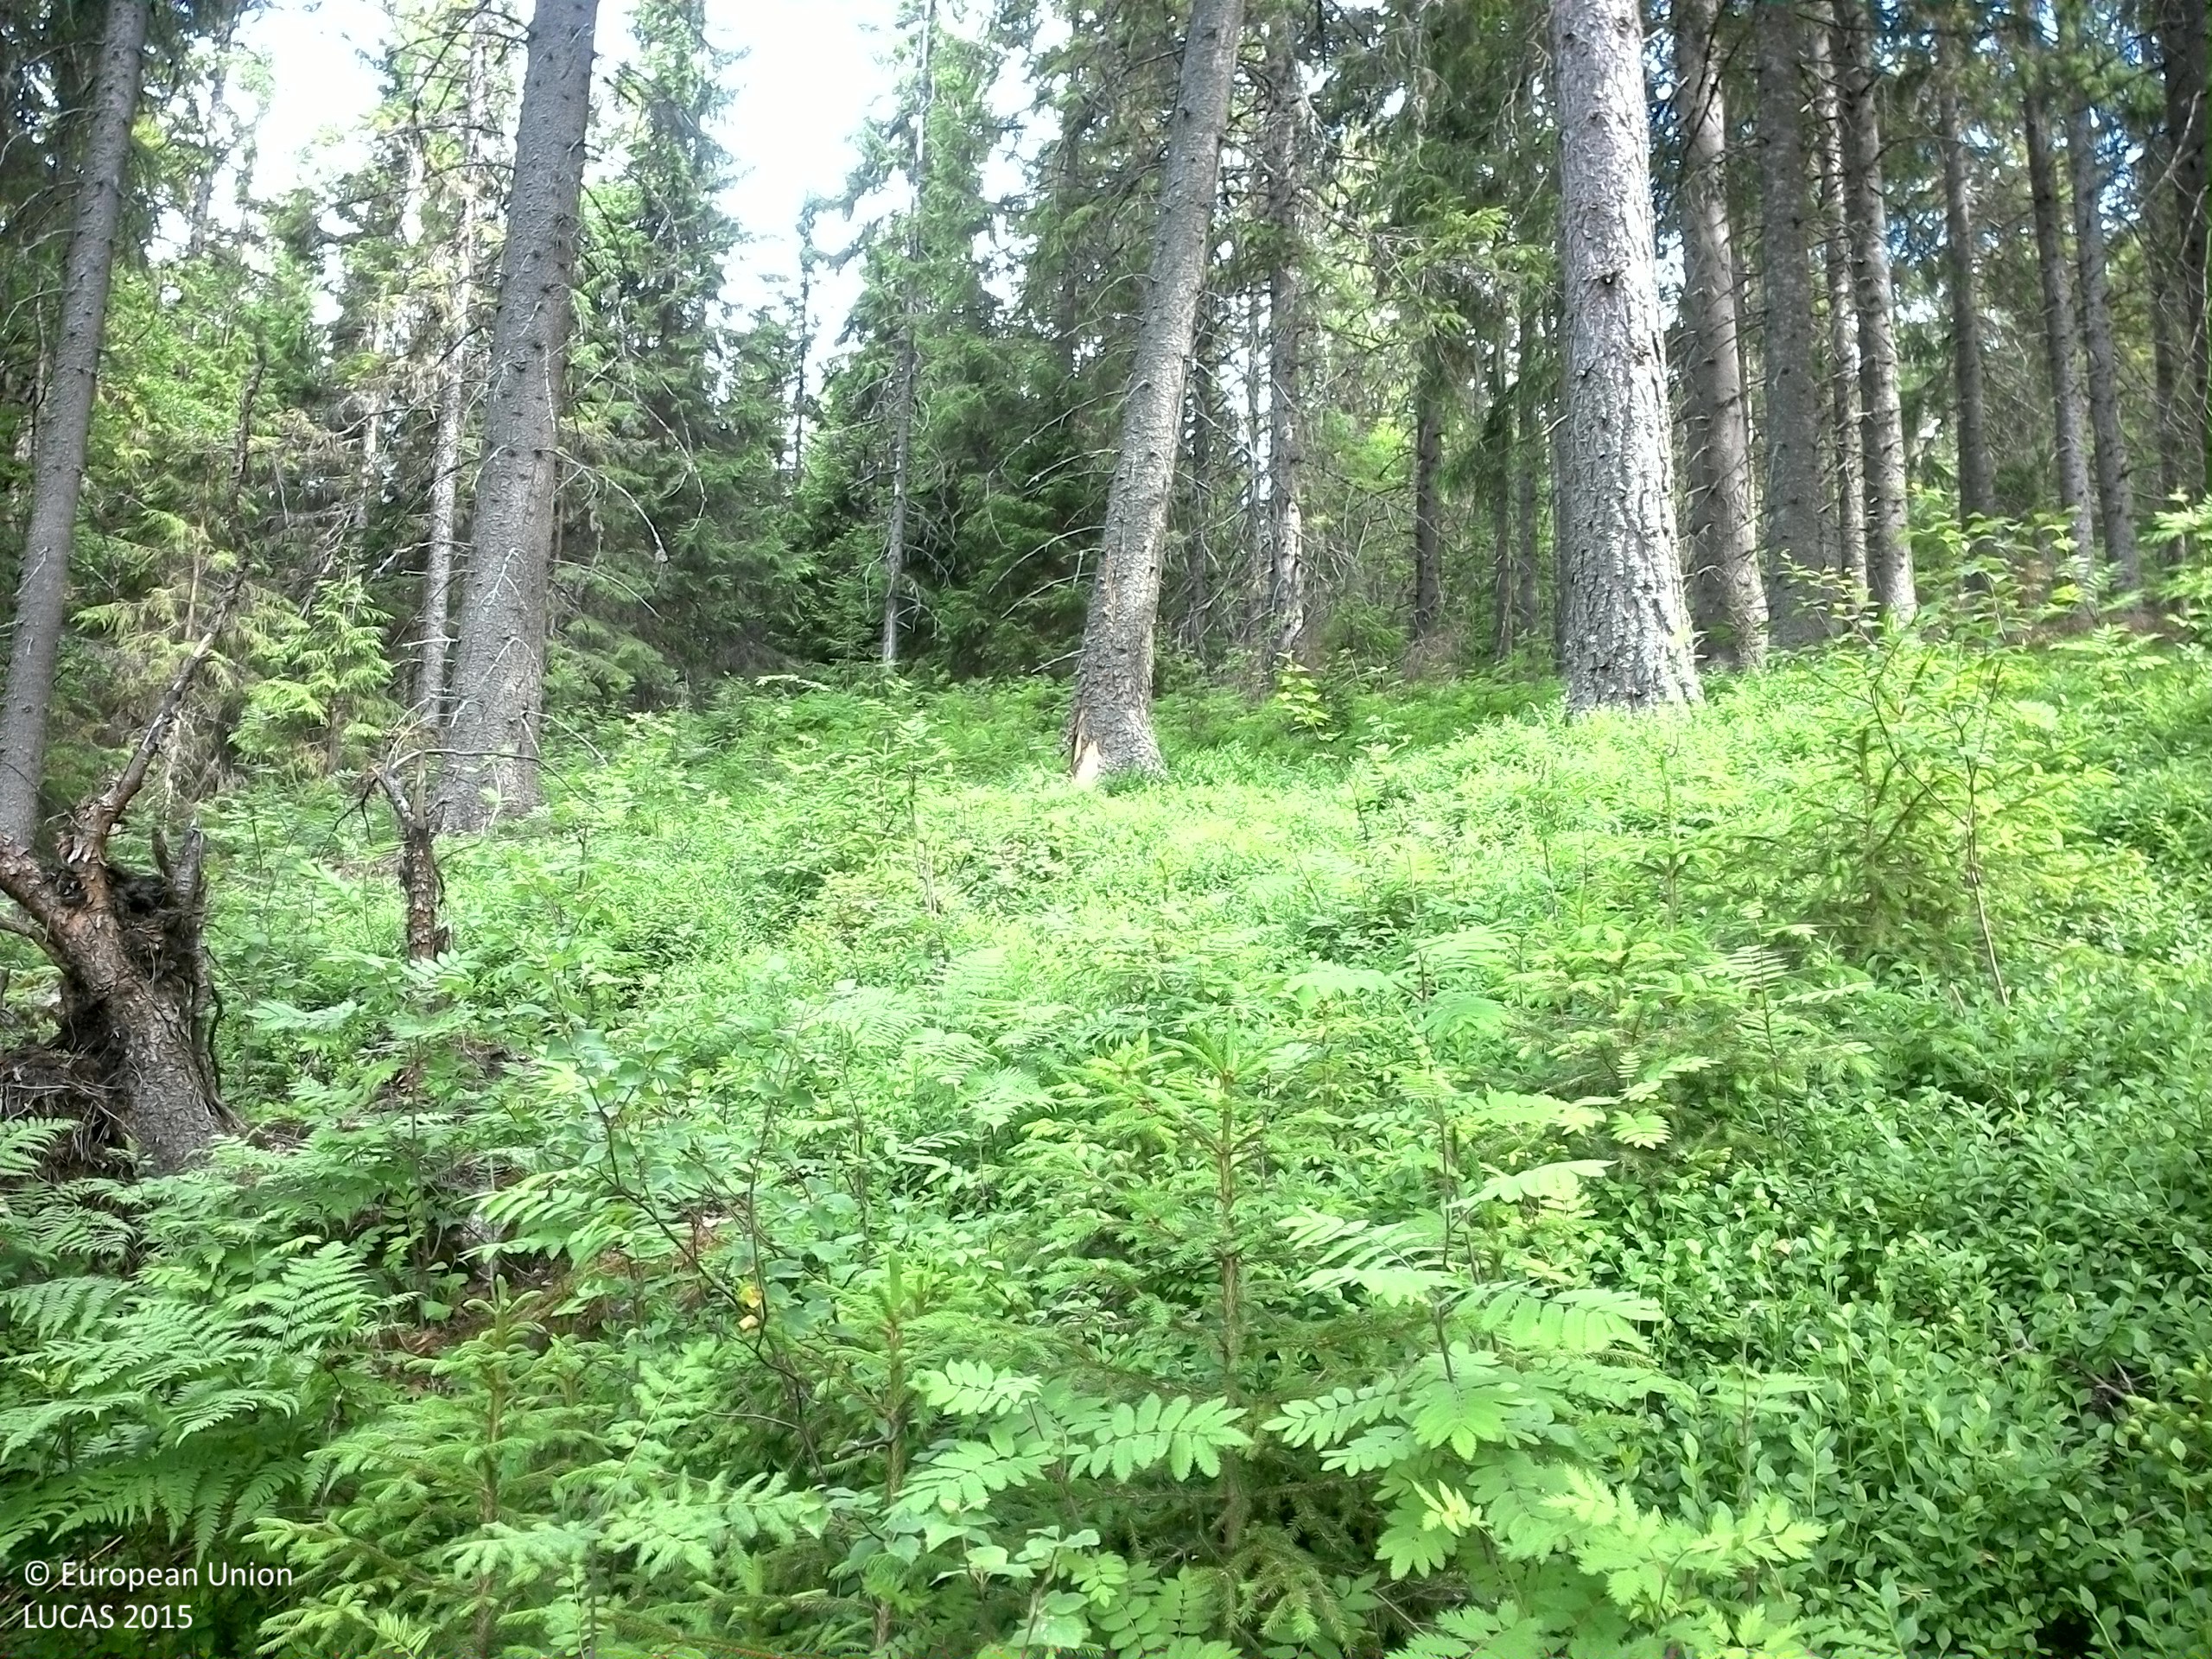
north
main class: Woodland
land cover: Spruce dominated mixed woodland
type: boreal forest
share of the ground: 50 - 75 %
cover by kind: shrubs 45 %, coniferous forest trees 40 %, broadleaved forest trees 15 %
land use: Forestry
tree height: > 5 m
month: June
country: SE
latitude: 62.8445
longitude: 17.8148
